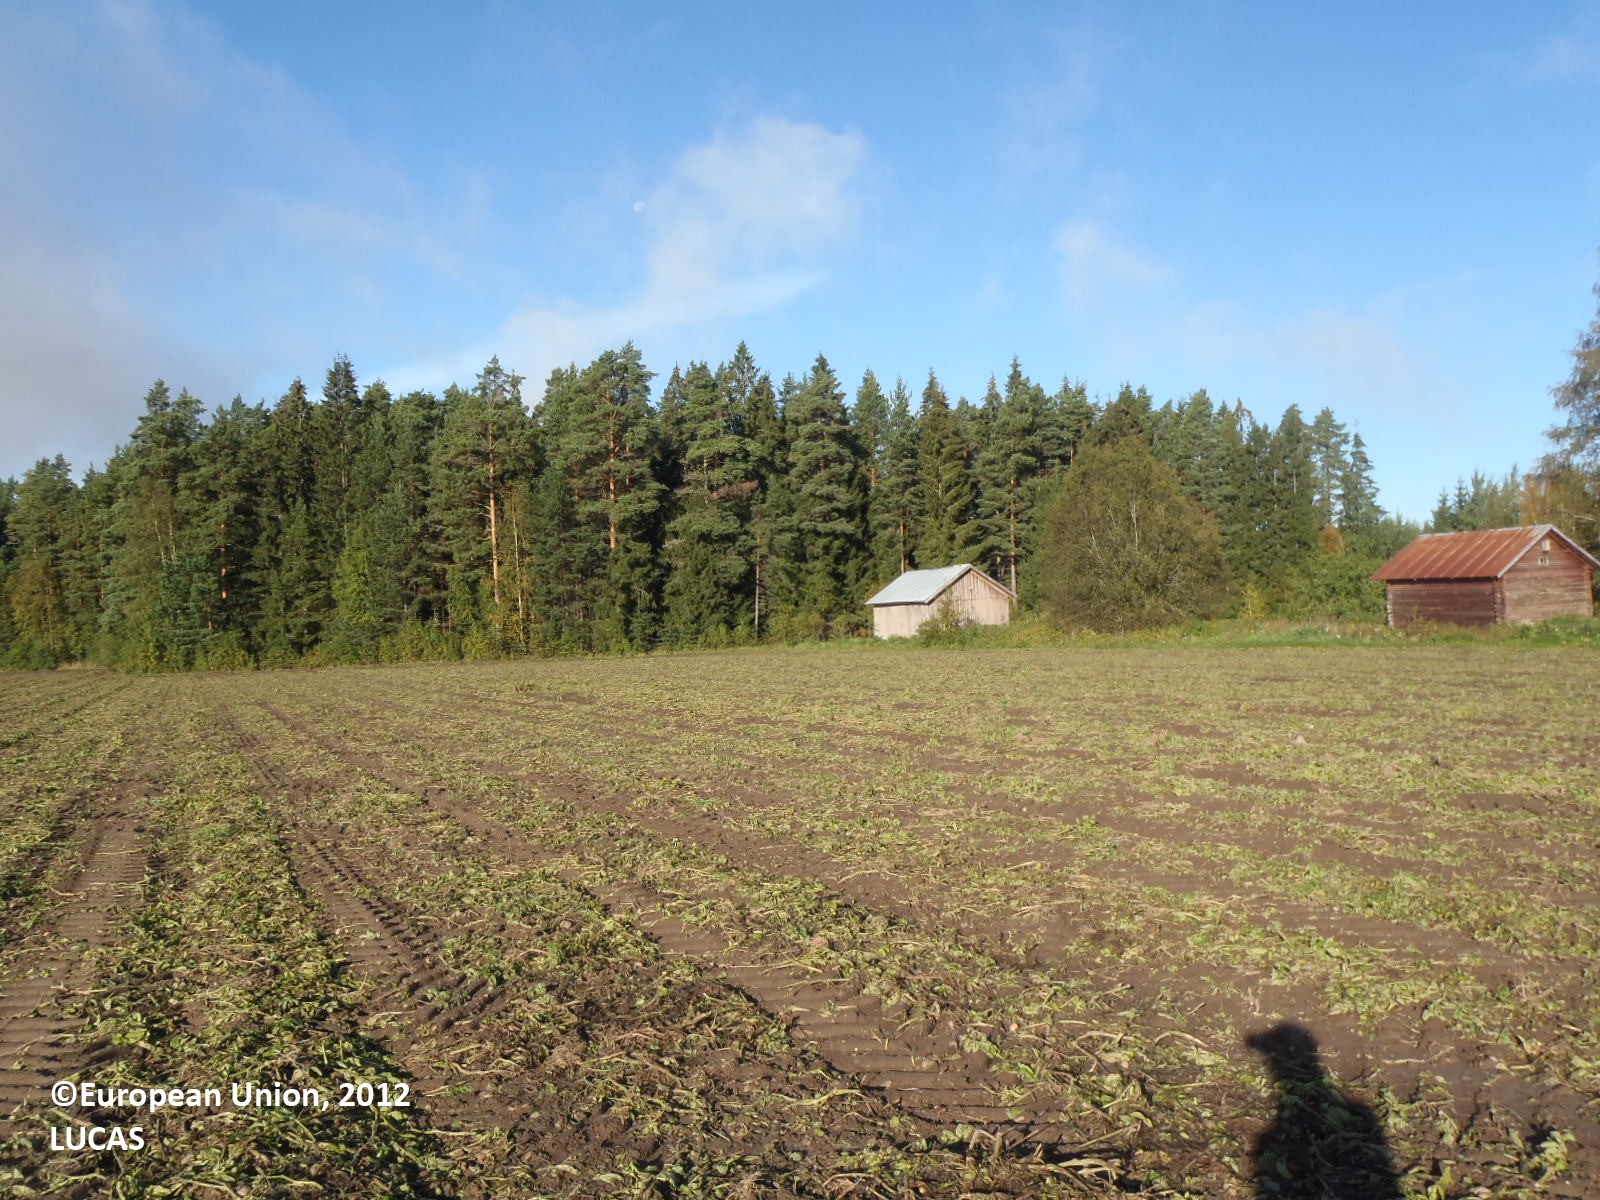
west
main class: Cropland
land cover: Potatoes
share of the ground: 50 - 75 %
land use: Agriculture (excluding fallow land and kitchen gardens)
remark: Harvested field
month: September
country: FI
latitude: 61.0537
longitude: 22.4197
